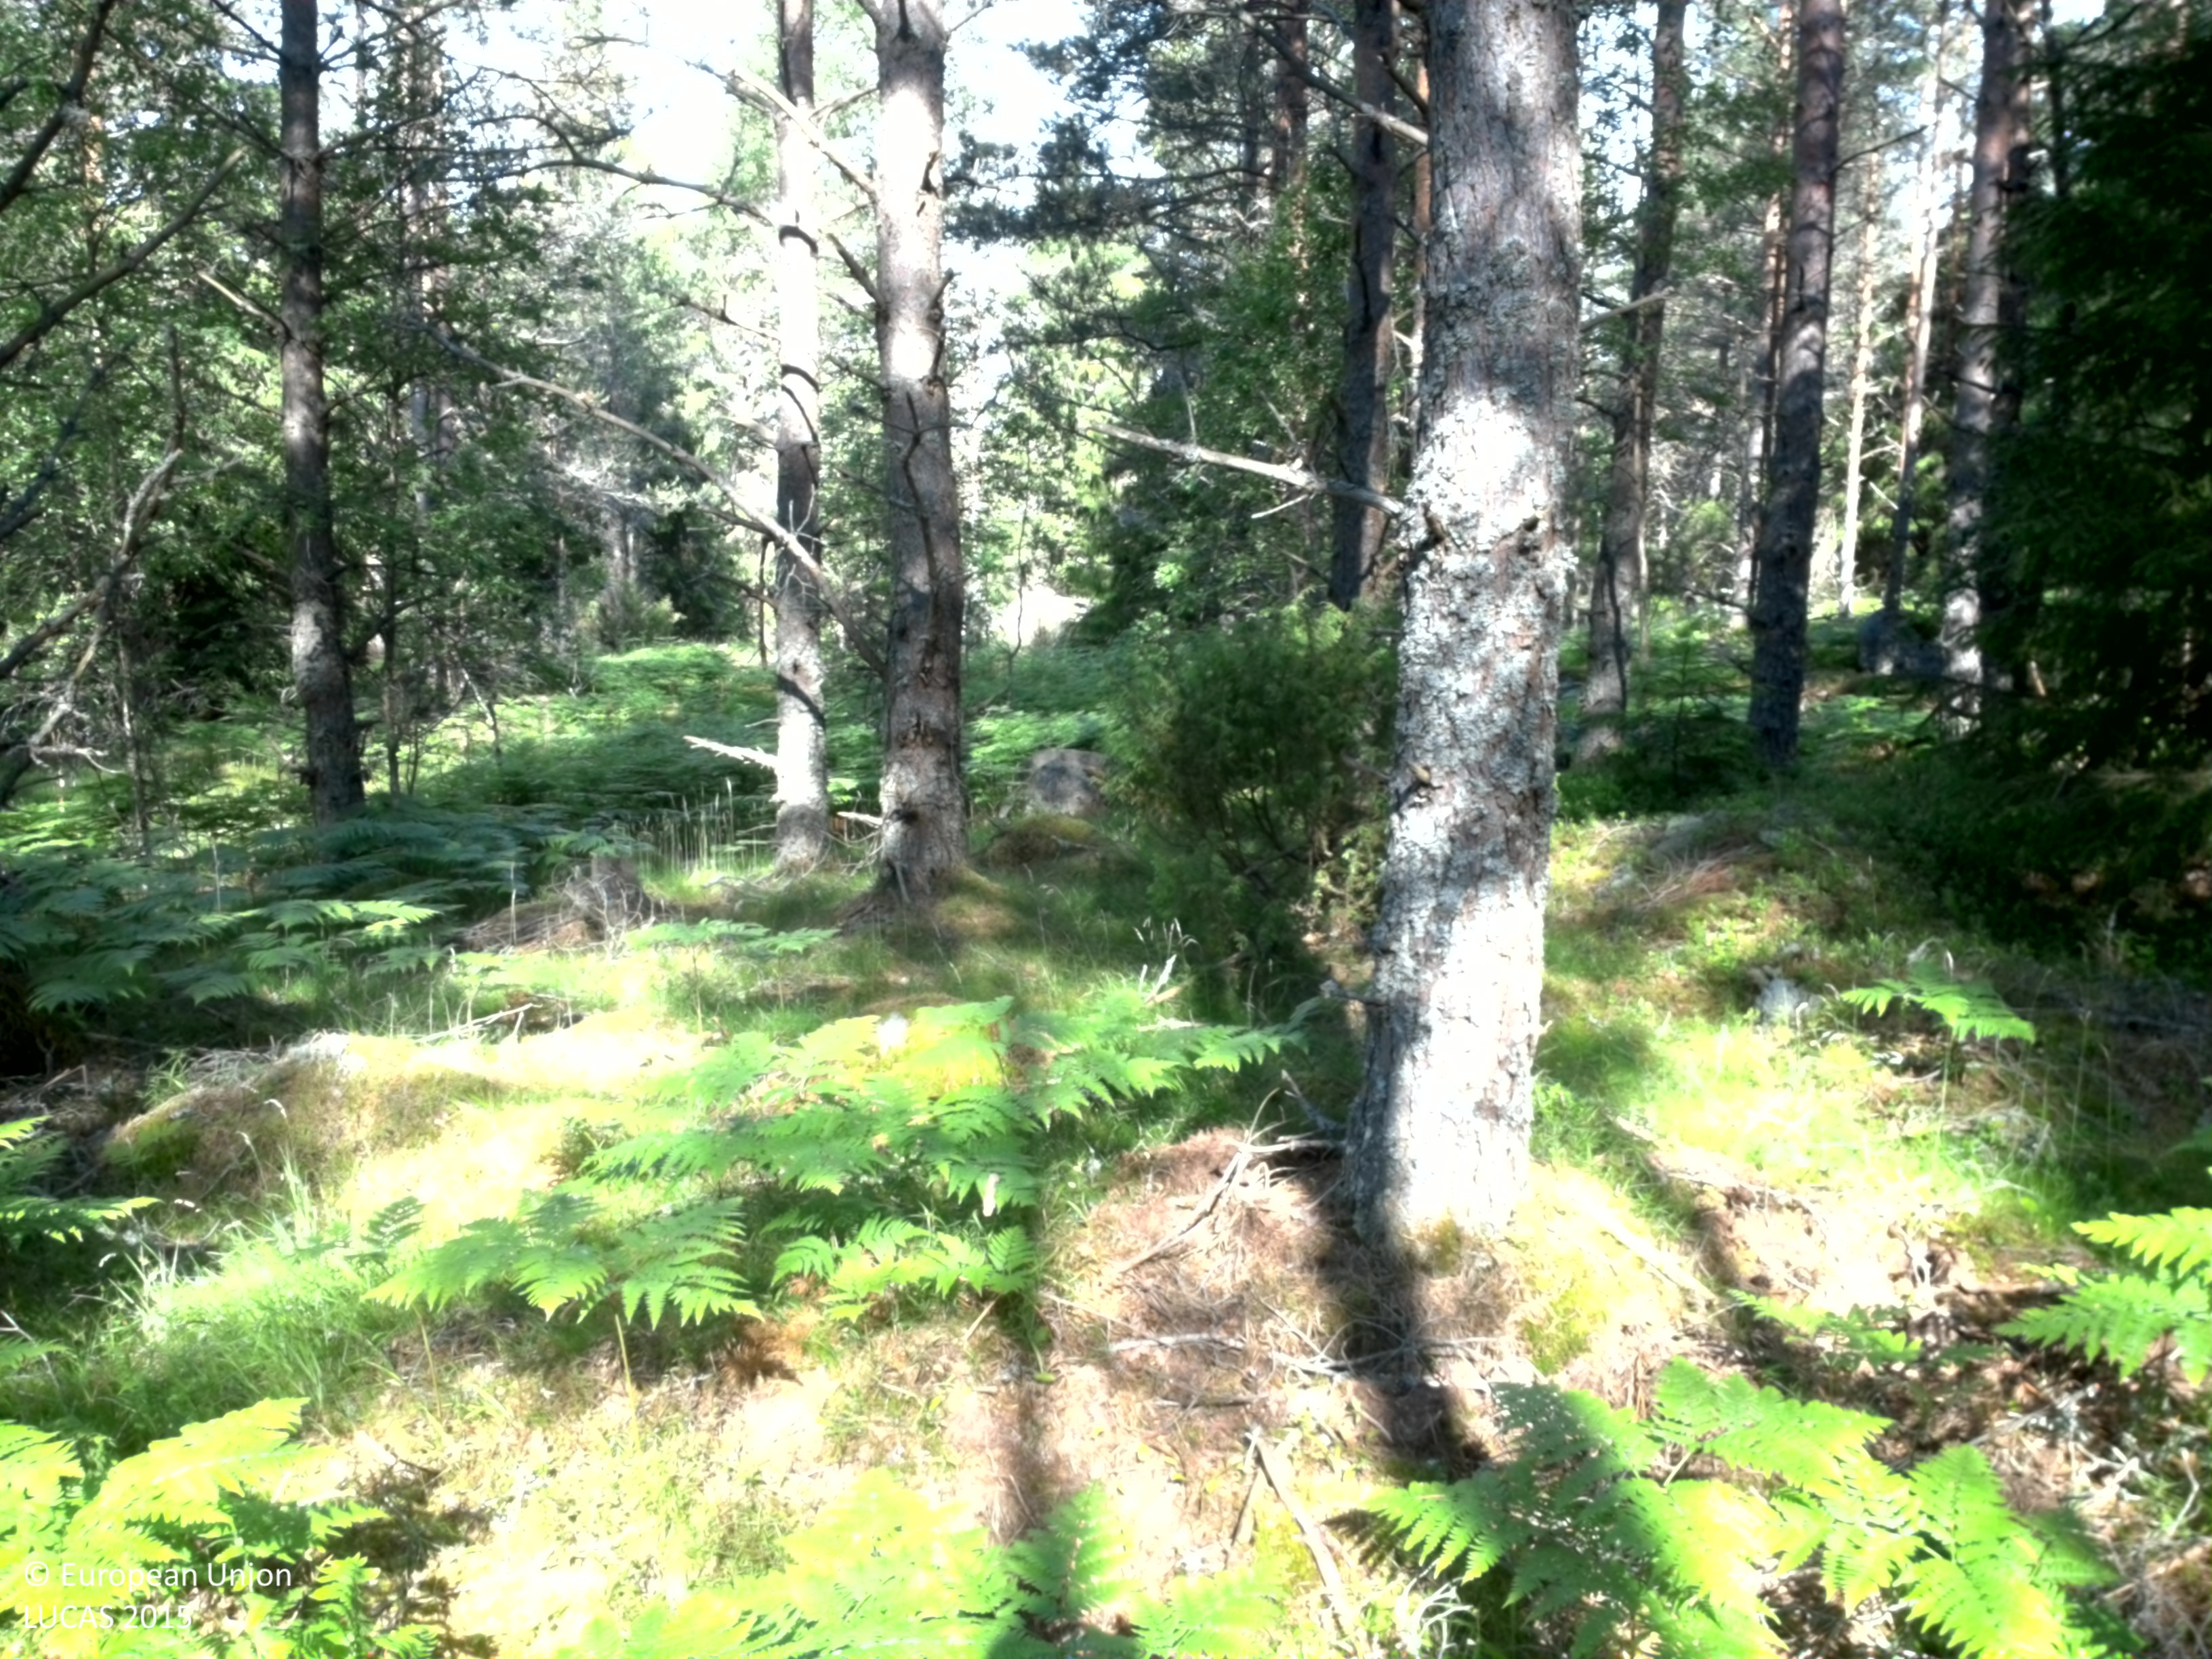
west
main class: Woodland
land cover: Pine dominated coniferous woodland
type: boreal forest
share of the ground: 25 - 50 %
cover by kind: herbaceous plants 55 %, coniferous forest trees 30 %, lichens and mosses 10 %, broadleaved forest trees 5 %
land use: Forestry
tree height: > 5 m
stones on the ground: 10 - 25 %
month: June
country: SE
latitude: 58.6126
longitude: 15.4852
